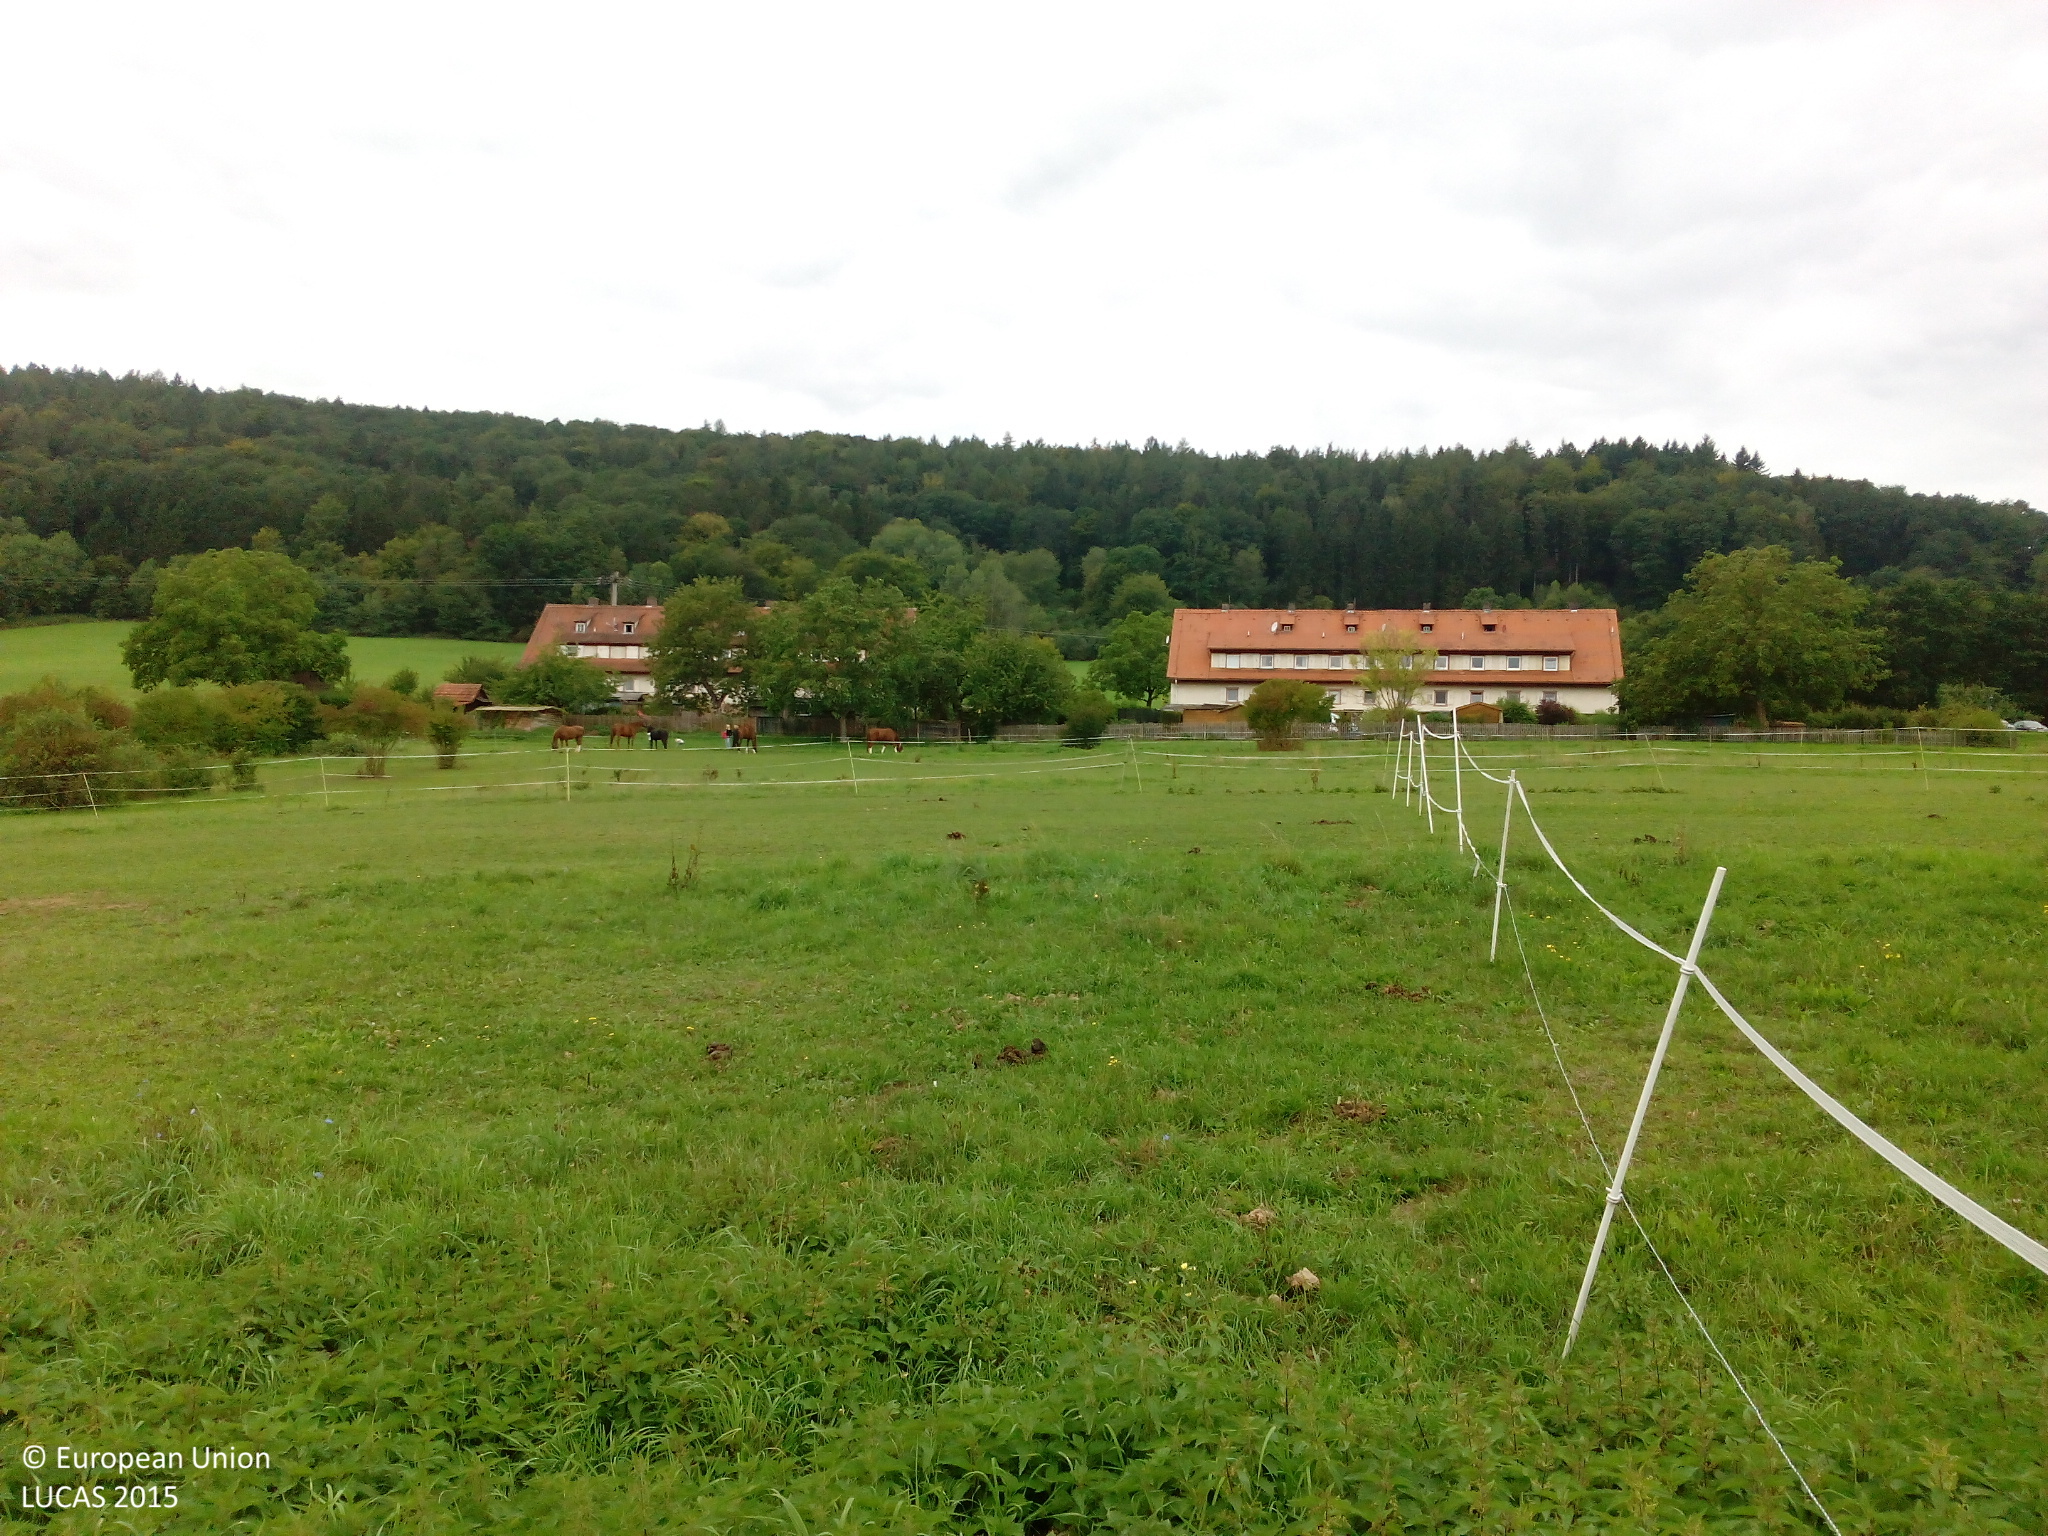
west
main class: Grassland
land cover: Grassland without tree/shrub cover
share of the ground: > 75 %
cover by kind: herbaceous plants 80 %, unconsolidated bare surface 20 %
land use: Agriculture (excluding fallow land and kitchen gardens)
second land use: Amenities, museums, leisure
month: September
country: DE
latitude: 49.9856
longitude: 9.5678
